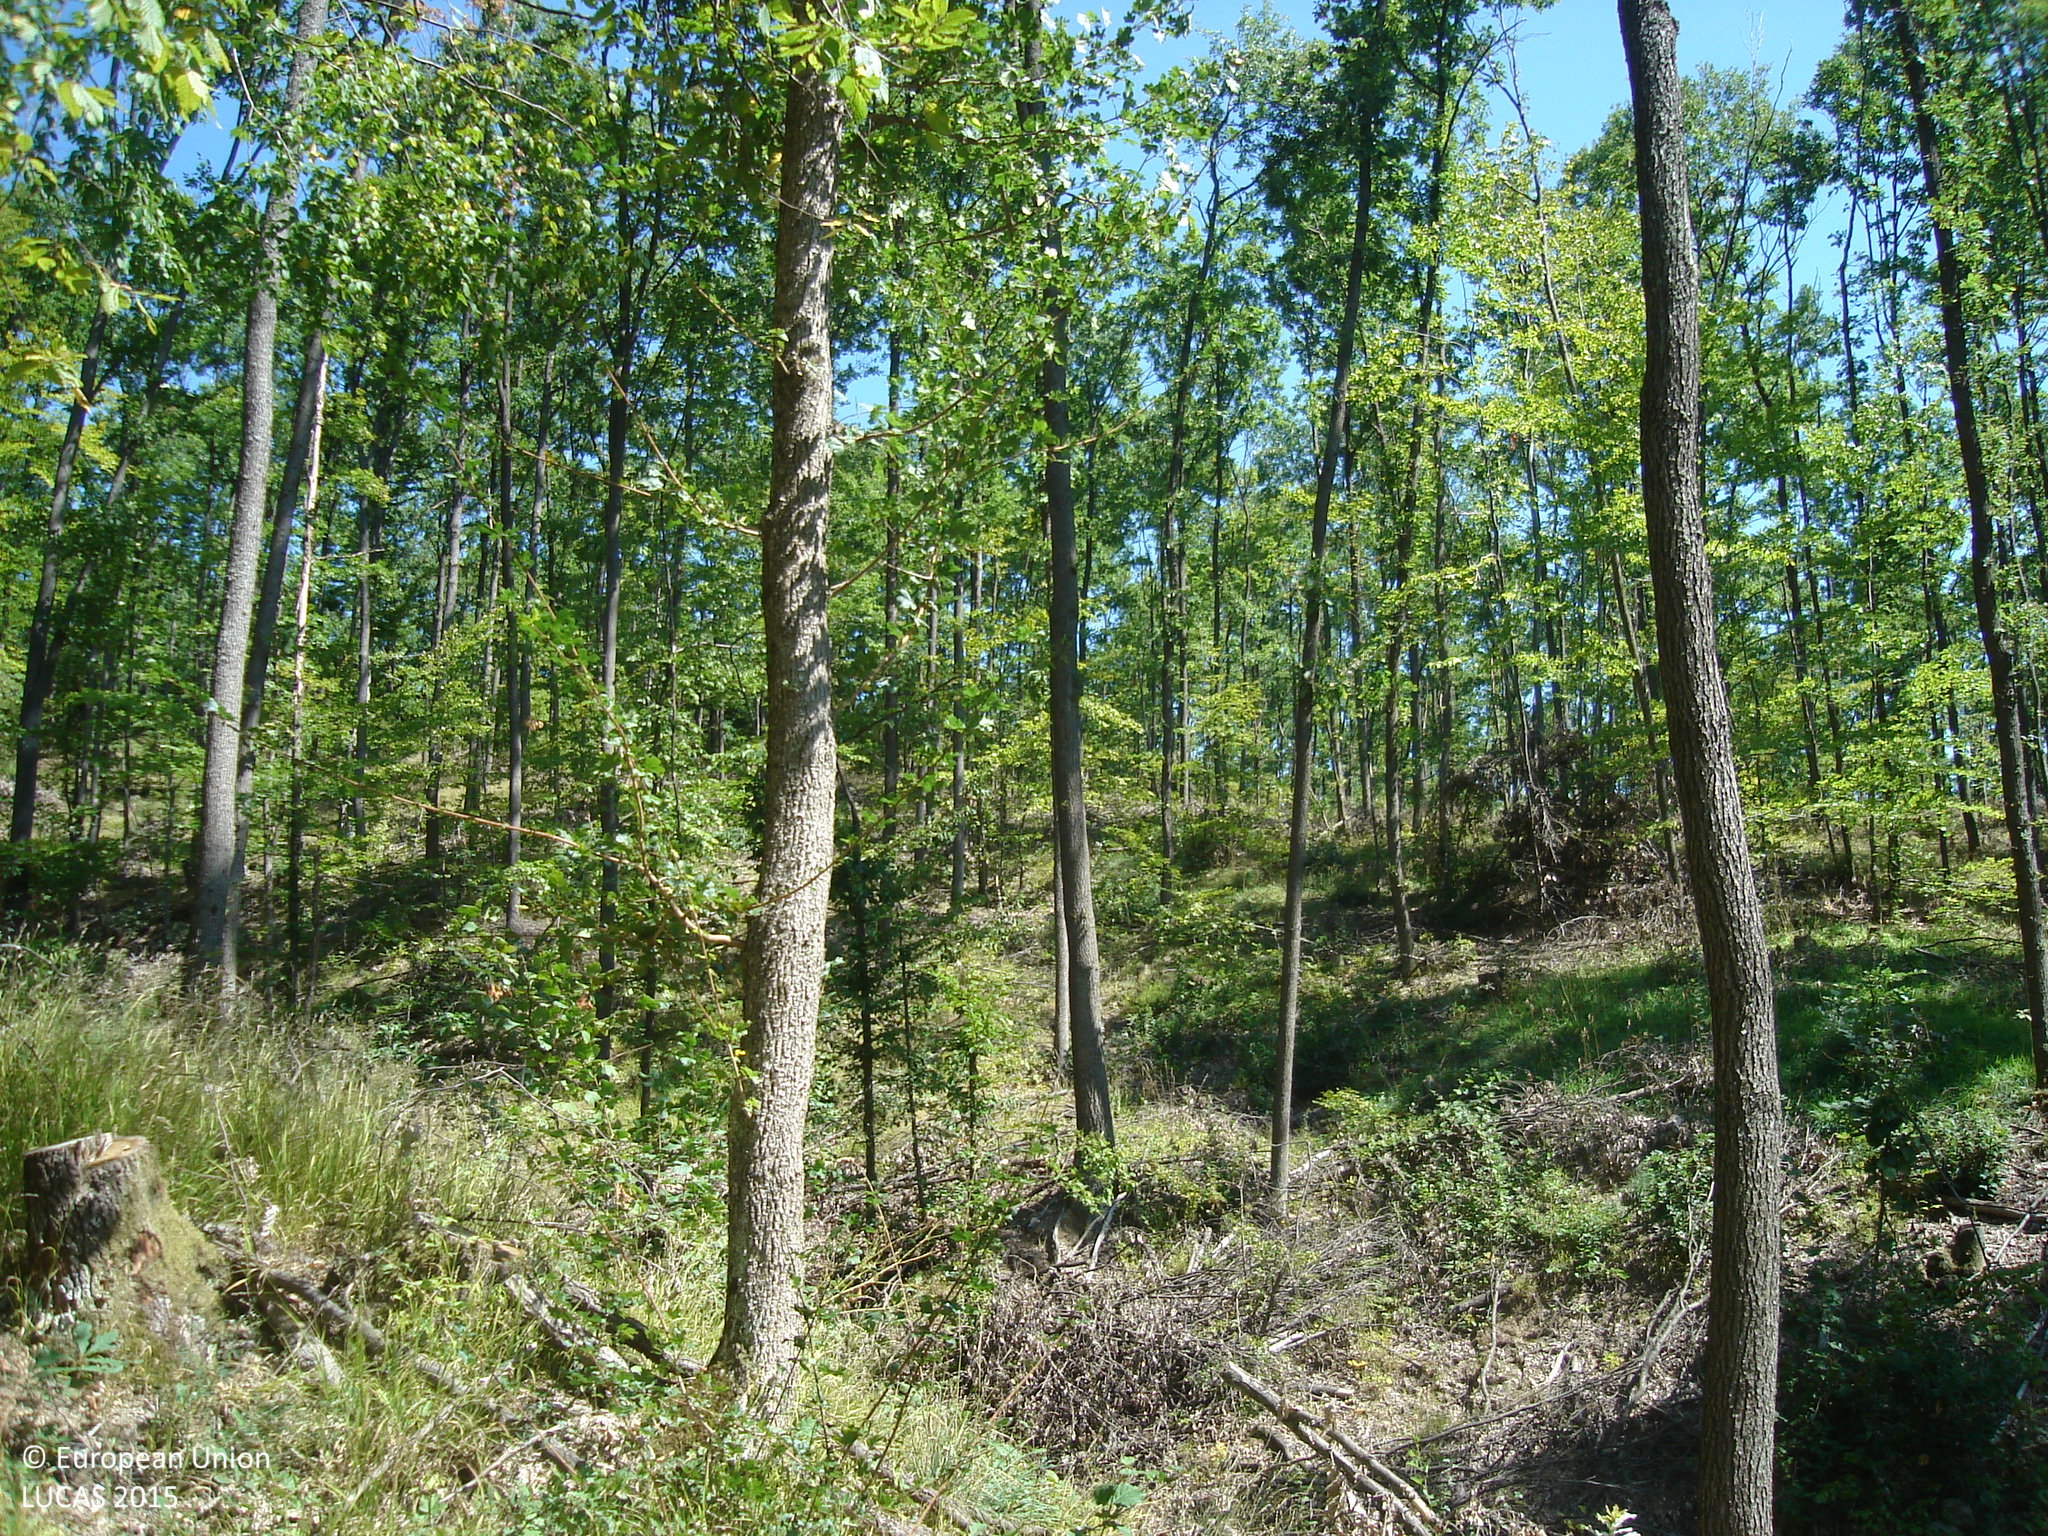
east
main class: Woodland
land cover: Broadleaved woodland
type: mesophytic deciduous forest
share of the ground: > 75 %
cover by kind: broadleaved forest trees 80 %, herbaceous plants 15 %, shrubs 5 %
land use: Forestry
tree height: > 5 m
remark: Clear cut
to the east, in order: Broadleaved woodland; Tracks; Broadleaved woodland; Tracks; Broadleaved woodland
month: September
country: BG
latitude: 42.5053
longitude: 23.8281
